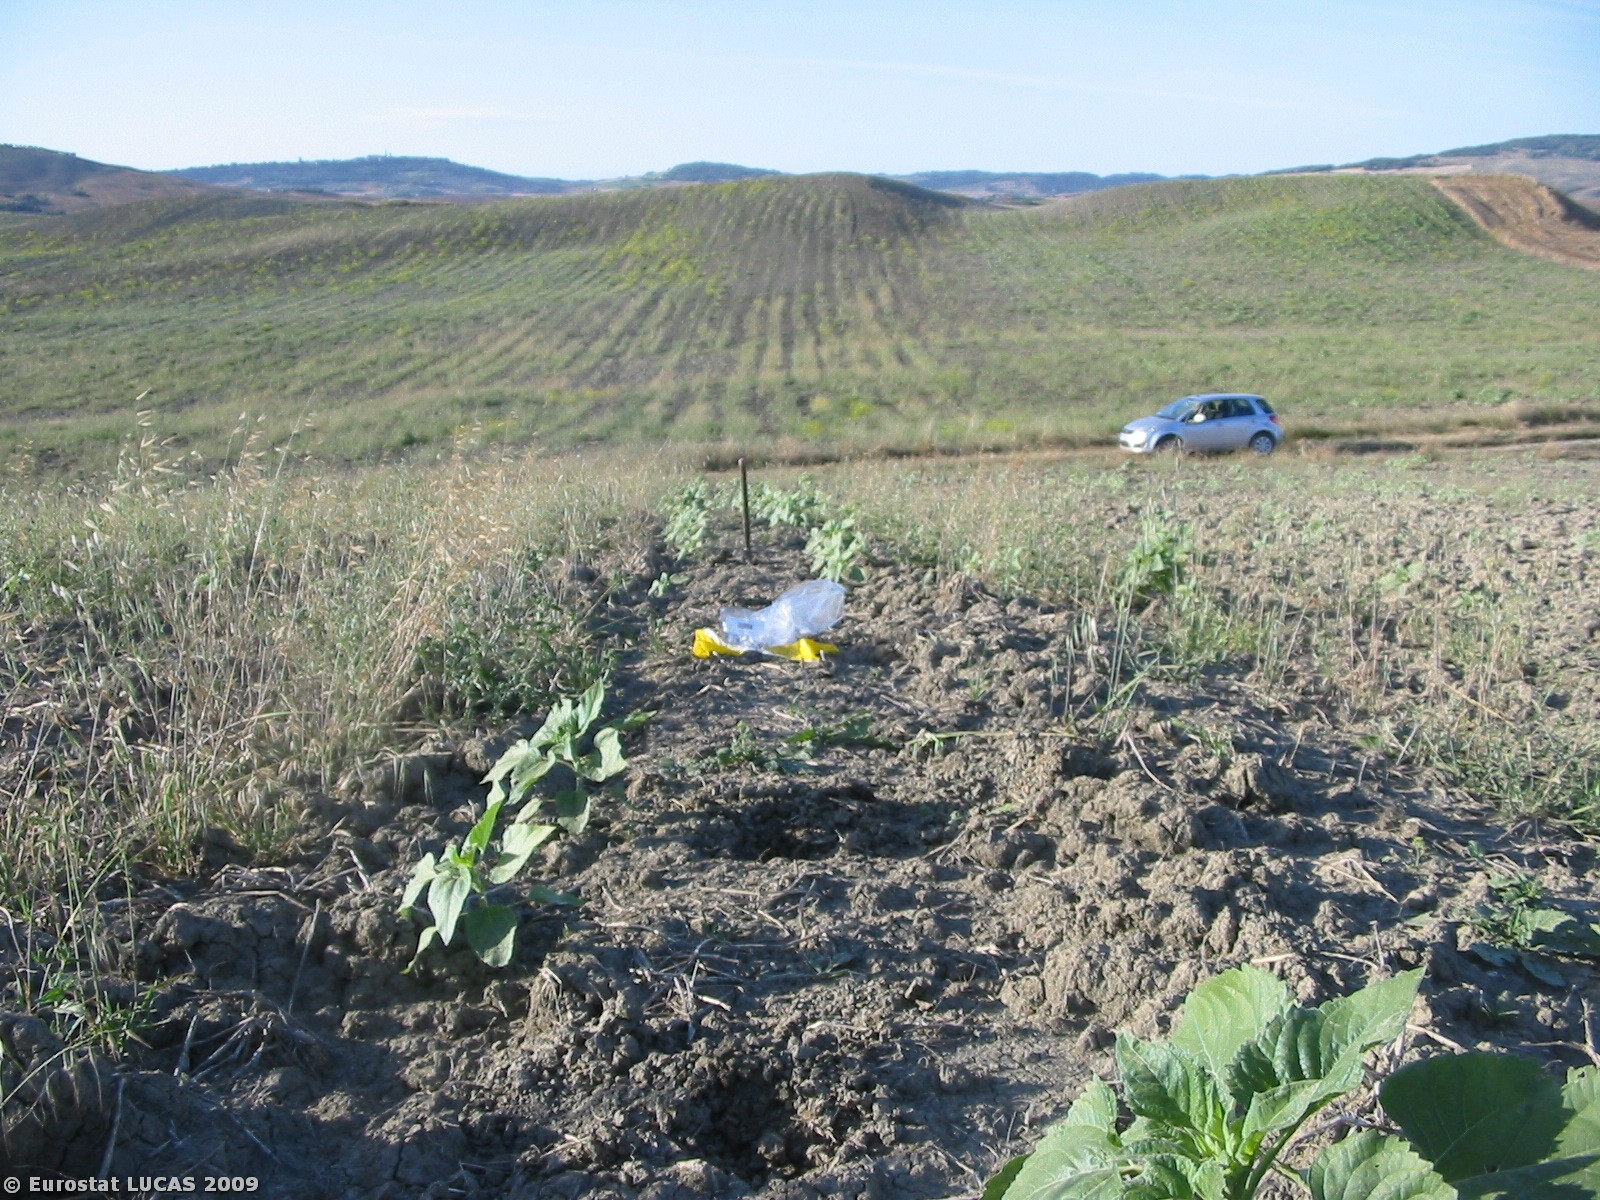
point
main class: Cropland
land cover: Sunflower
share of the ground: 10 - 25 %
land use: Agriculture (excluding fallow land and kitchen gardens)
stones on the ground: < 10 %
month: July
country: IT
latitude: 43.0194
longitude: 11.6760
